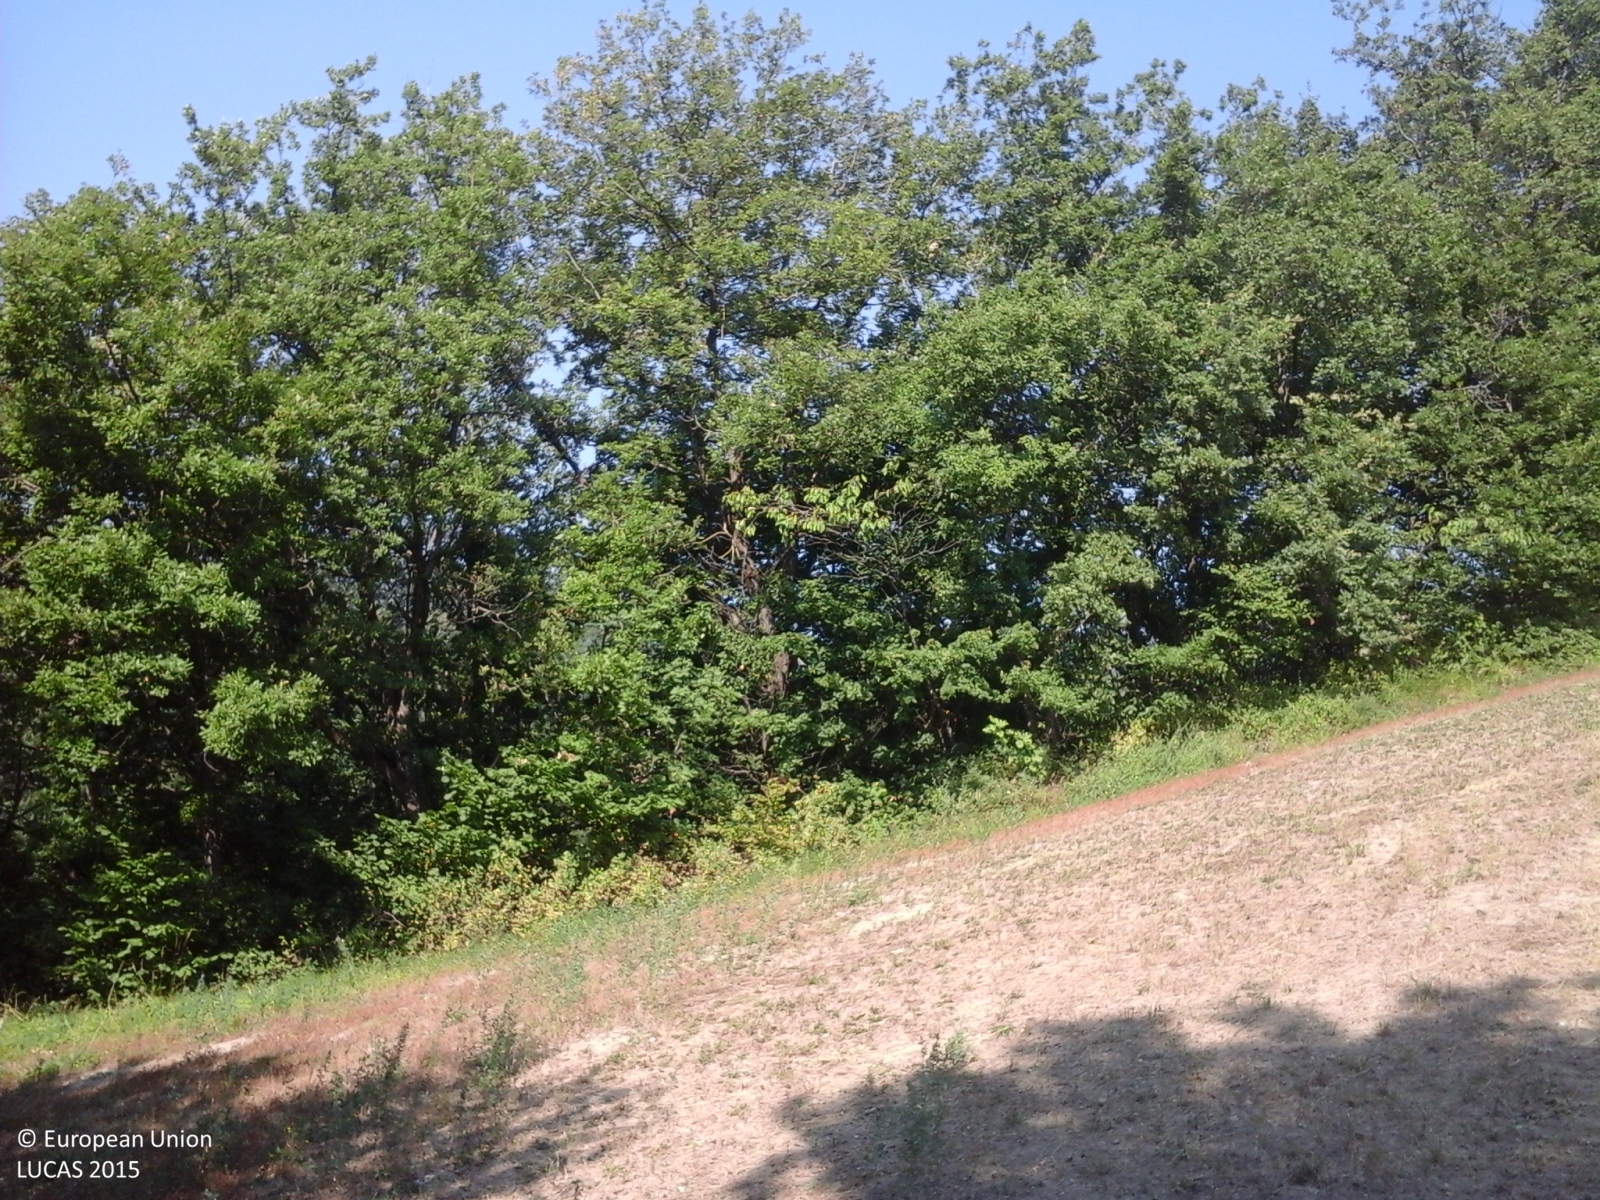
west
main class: Grassland
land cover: Grassland without tree/shrub cover
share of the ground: > 75 %
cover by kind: herbaceous plants 100 %
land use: Agriculture (excluding fallow land and kitchen gardens)
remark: Clear cut
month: July
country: IT
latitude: 44.4944
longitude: 10.3137
